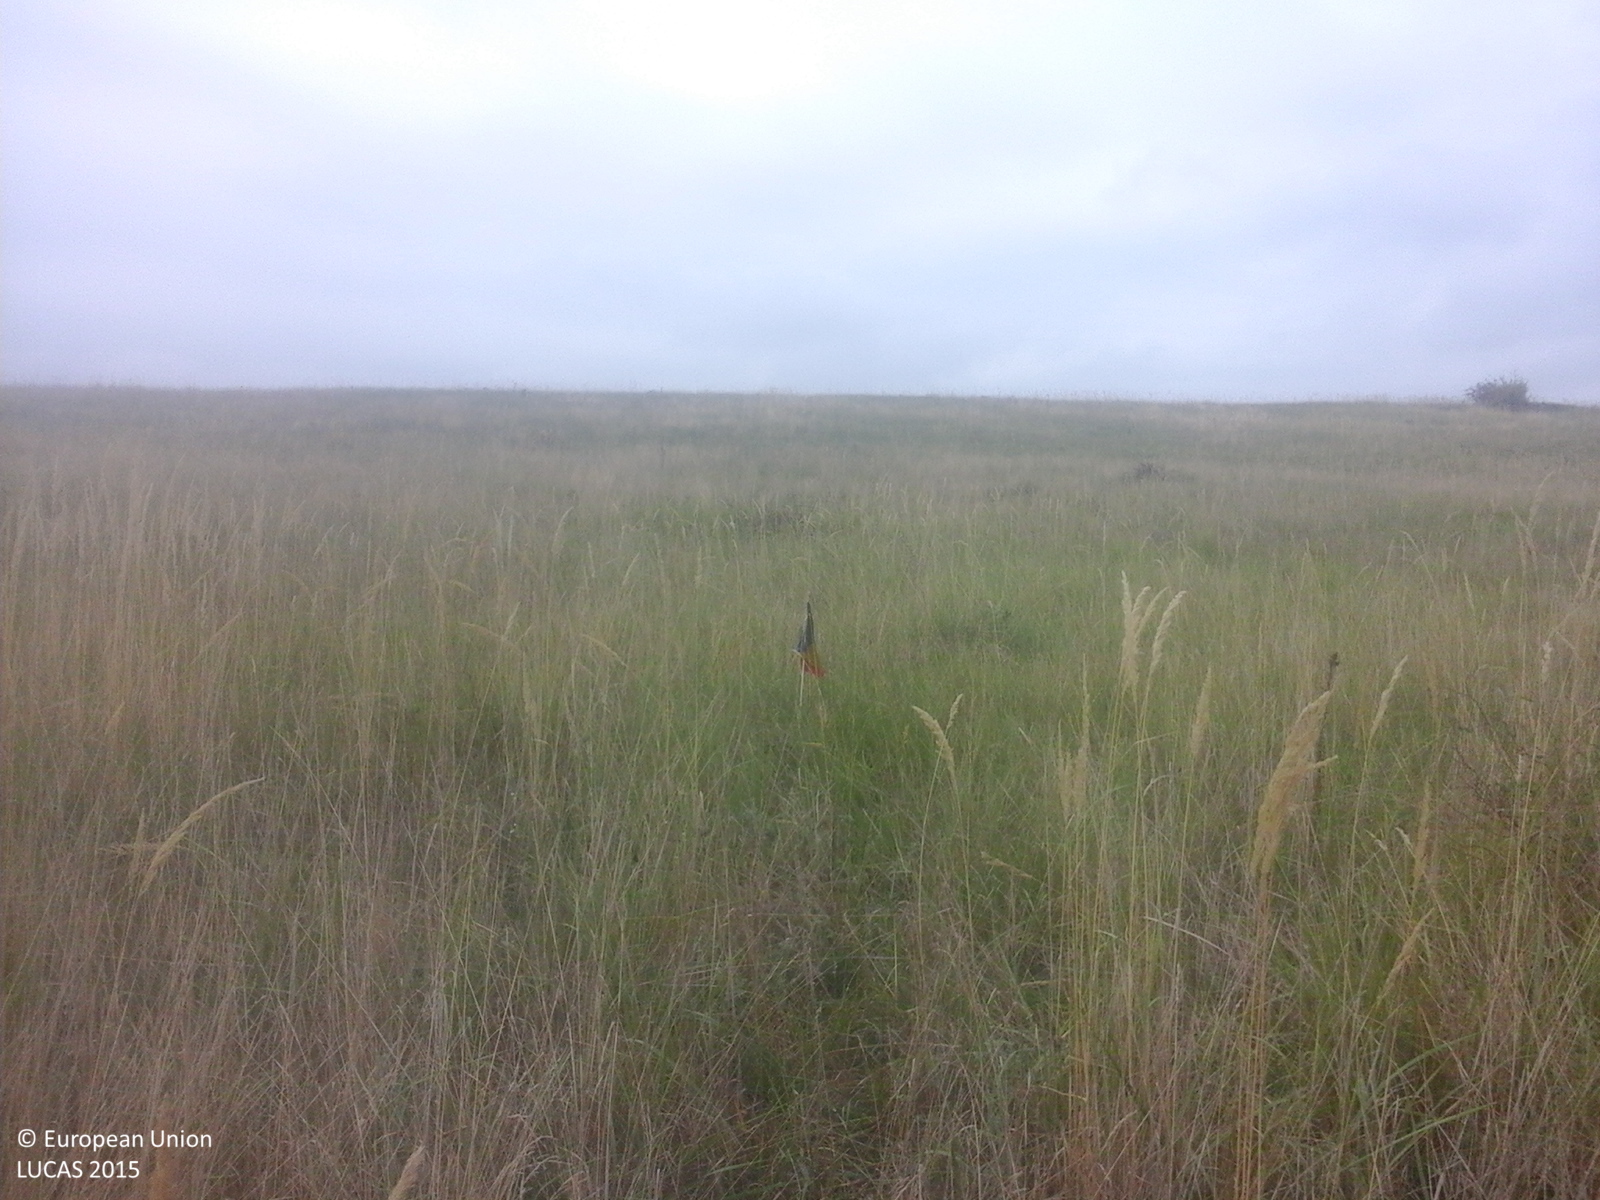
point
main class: Grassland
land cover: Grassland without tree/shrub cover
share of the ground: > 75 %
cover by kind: herbaceous plants 100 %
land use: Agriculture (excluding fallow land and kitchen gardens)
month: September
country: RO
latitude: 45.8811
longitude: 22.0894
